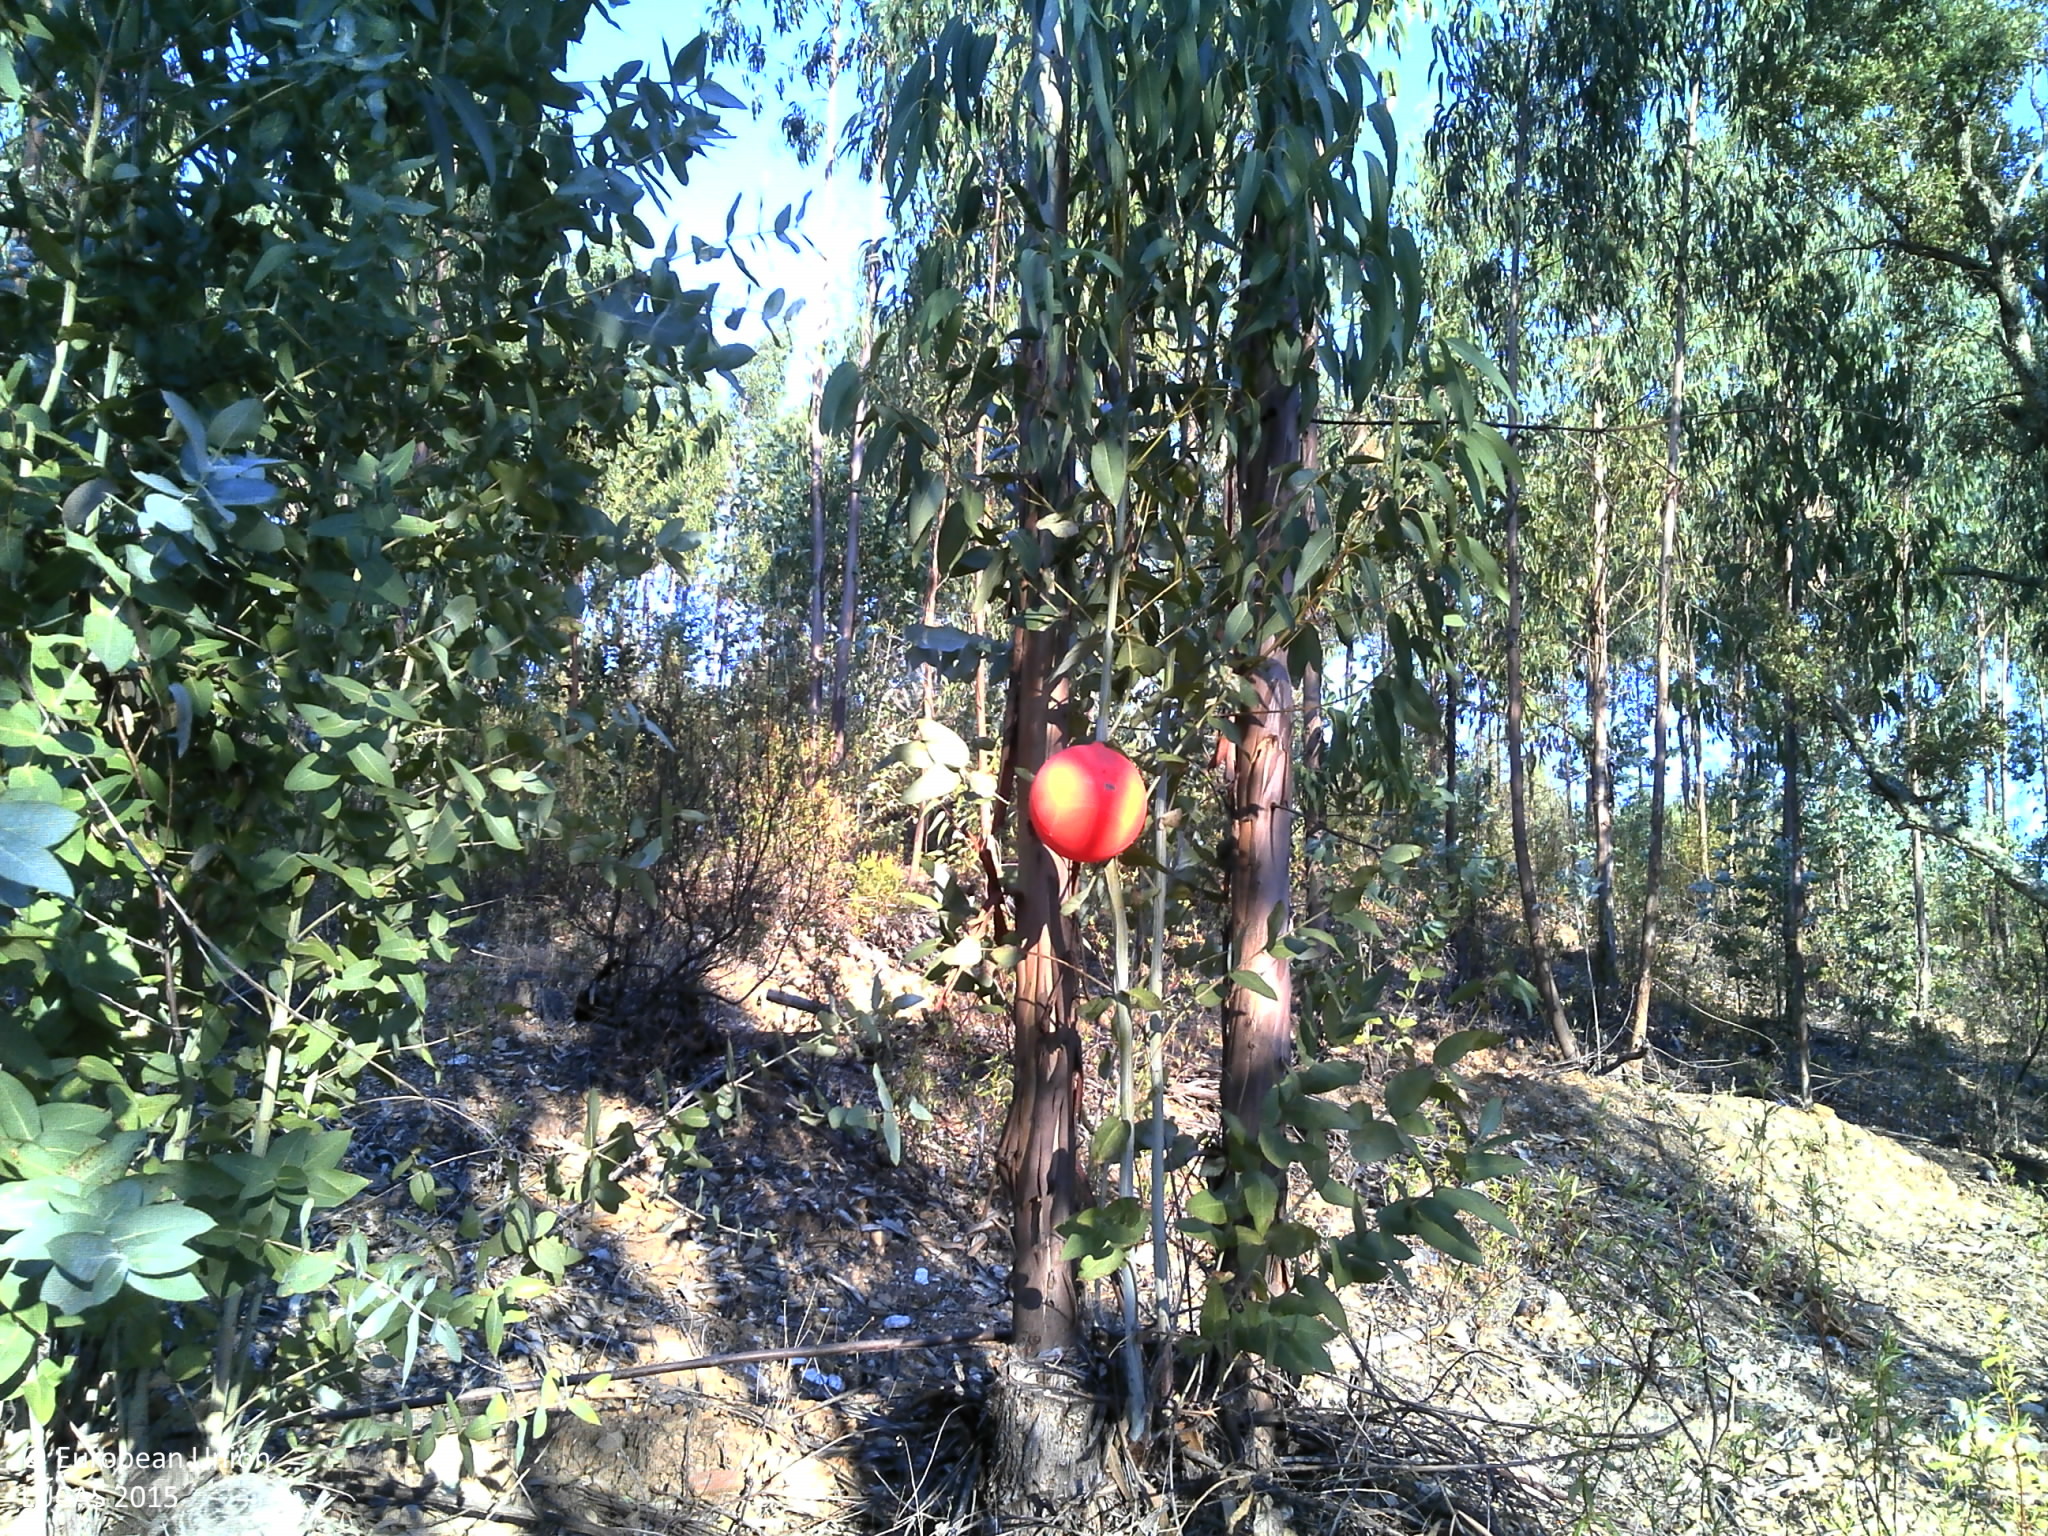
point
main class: Woodland
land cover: Broadleaved woodland
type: exotic forest
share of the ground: > 75 %
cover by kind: broadleaved forest trees 75 %, shrubs 25 %
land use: Forestry
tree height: > 5 m
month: August
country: PT
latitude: 39.6127
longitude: -7.6523
